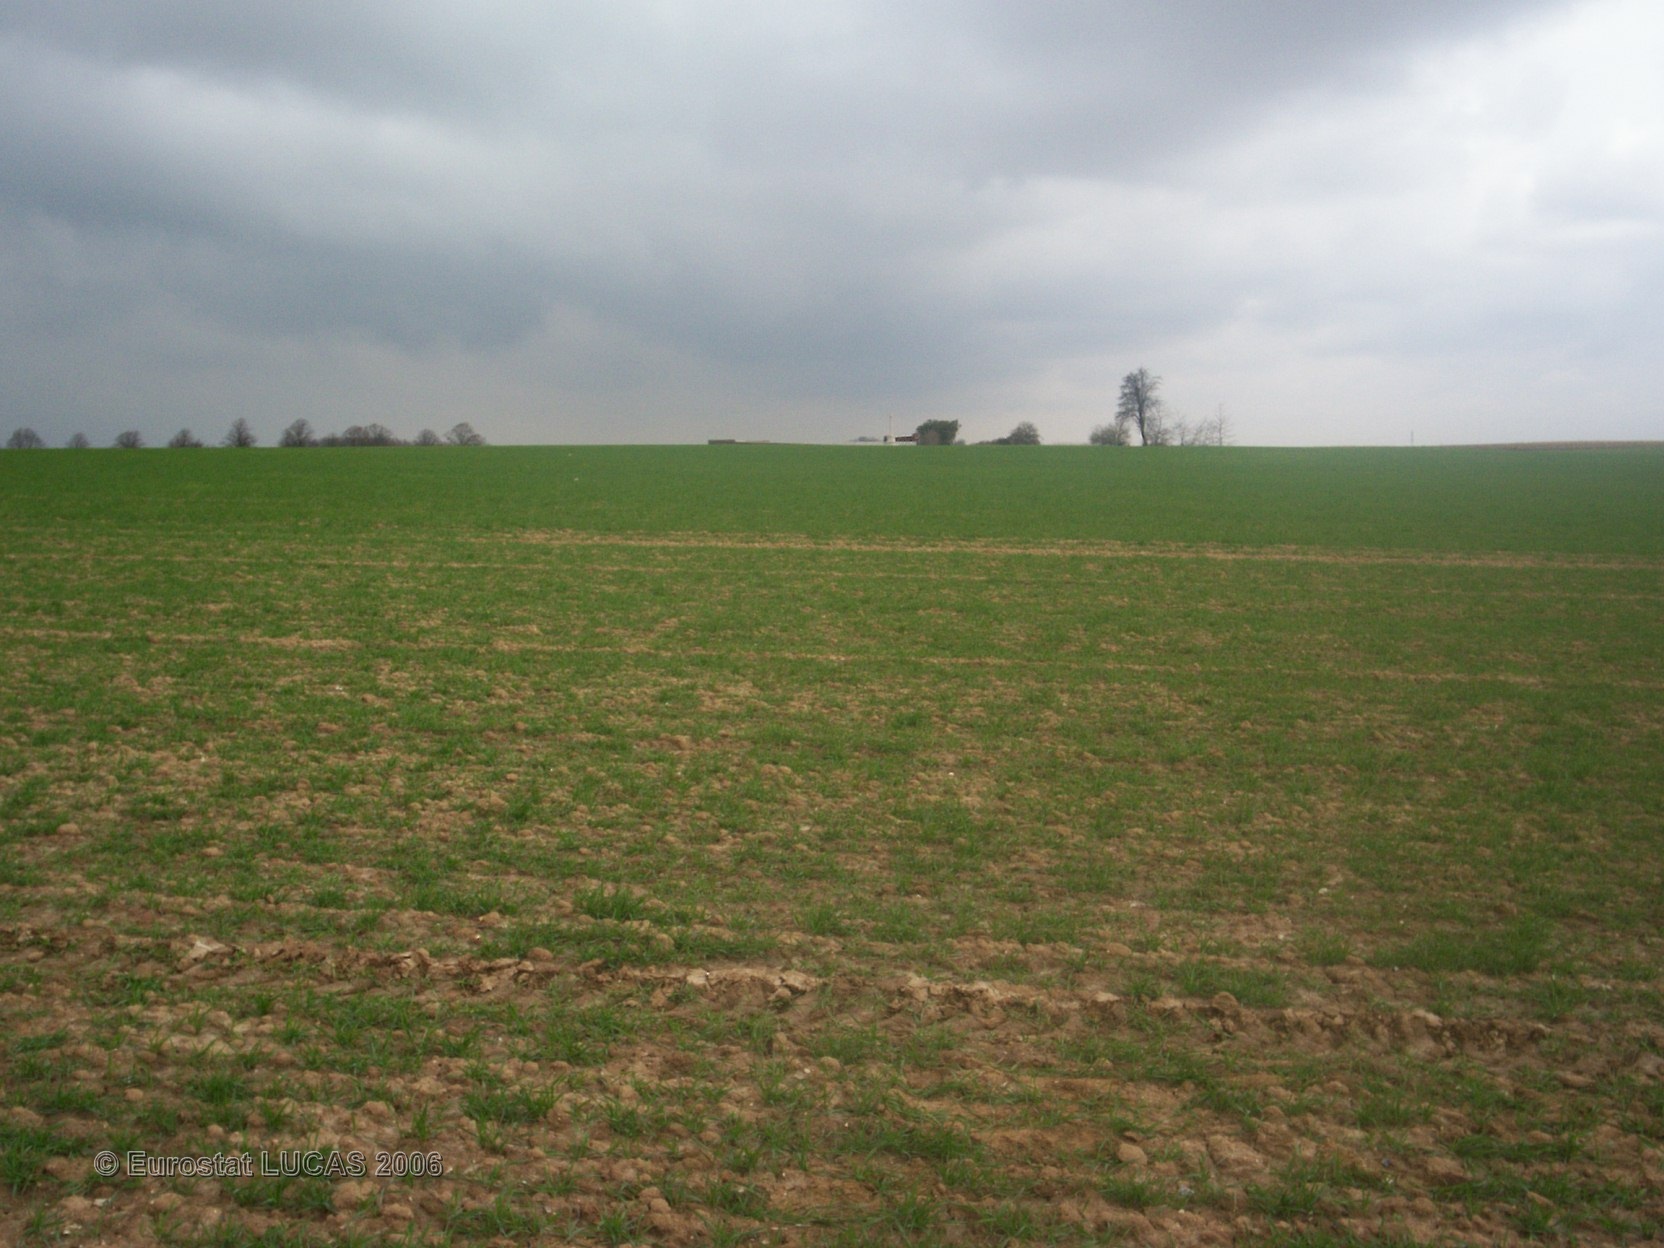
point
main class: Cropland
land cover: Common wheat
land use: Agriculture (excluding fallow land and kitchen gardens)
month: April
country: FR
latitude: 50.0913
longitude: 2.6501
